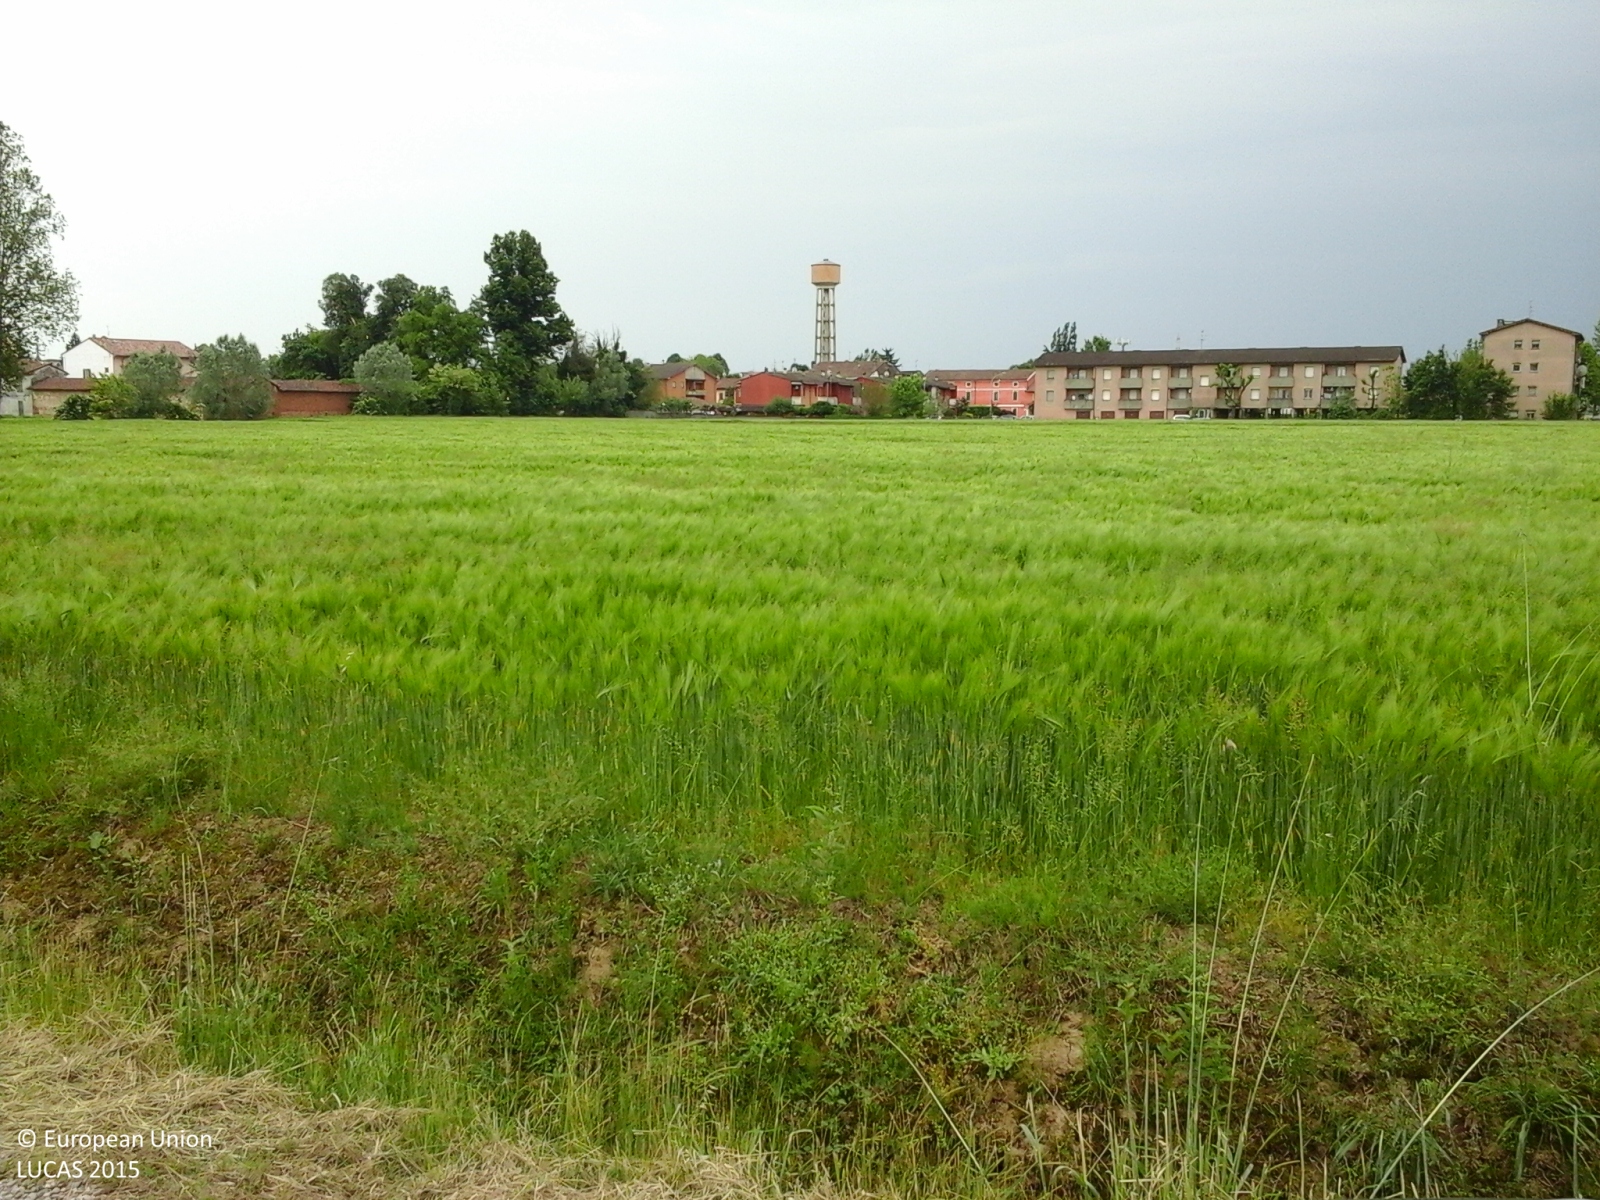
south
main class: Cropland
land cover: Common wheat
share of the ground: > 75 %
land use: Agriculture (excluding fallow land and kitchen gardens)
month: May
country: IT
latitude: 45.1799
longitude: 9.9111
